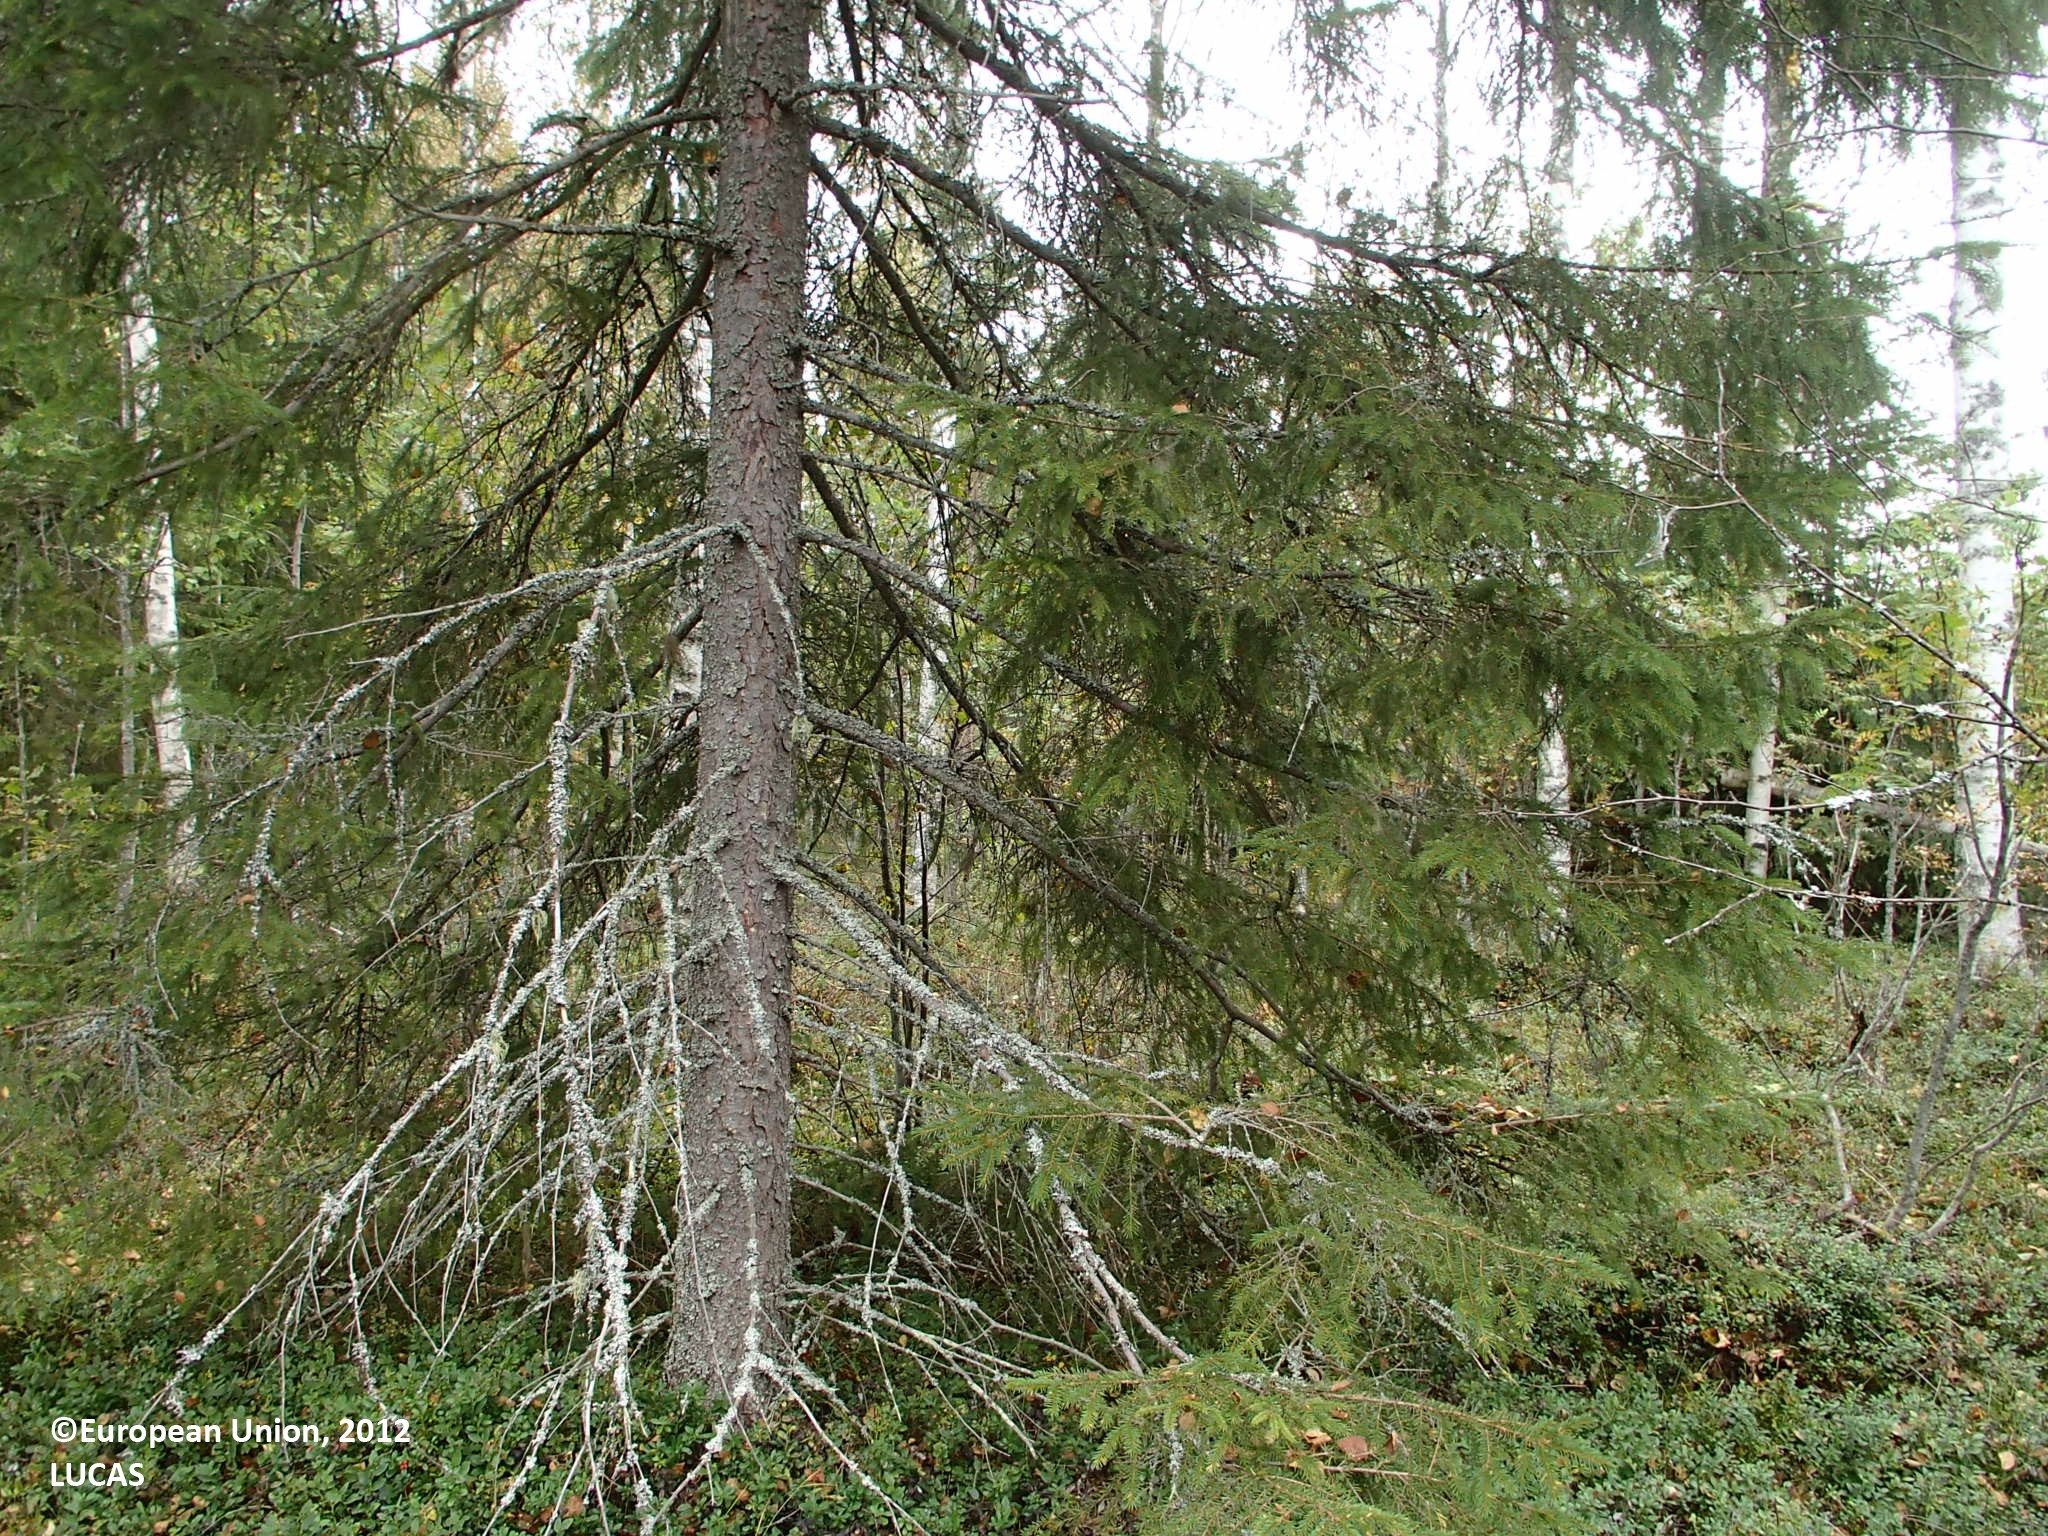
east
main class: Woodland
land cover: Other mixed woodland
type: boreal forest
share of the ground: > 75 %
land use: Forestry
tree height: > 5 m
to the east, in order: Other mixed woodland; Spruce dominated coniferous woodland; Ditches and canals; Grass margins; Paved roads, cycling and walking lanes; Grass margins; Ditches and canals; Other mixed woodland; Ditches and canals; Other mixed woodland; Pine dominated mixed woodland
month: September
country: FI
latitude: 63.8214
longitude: 25.9763
